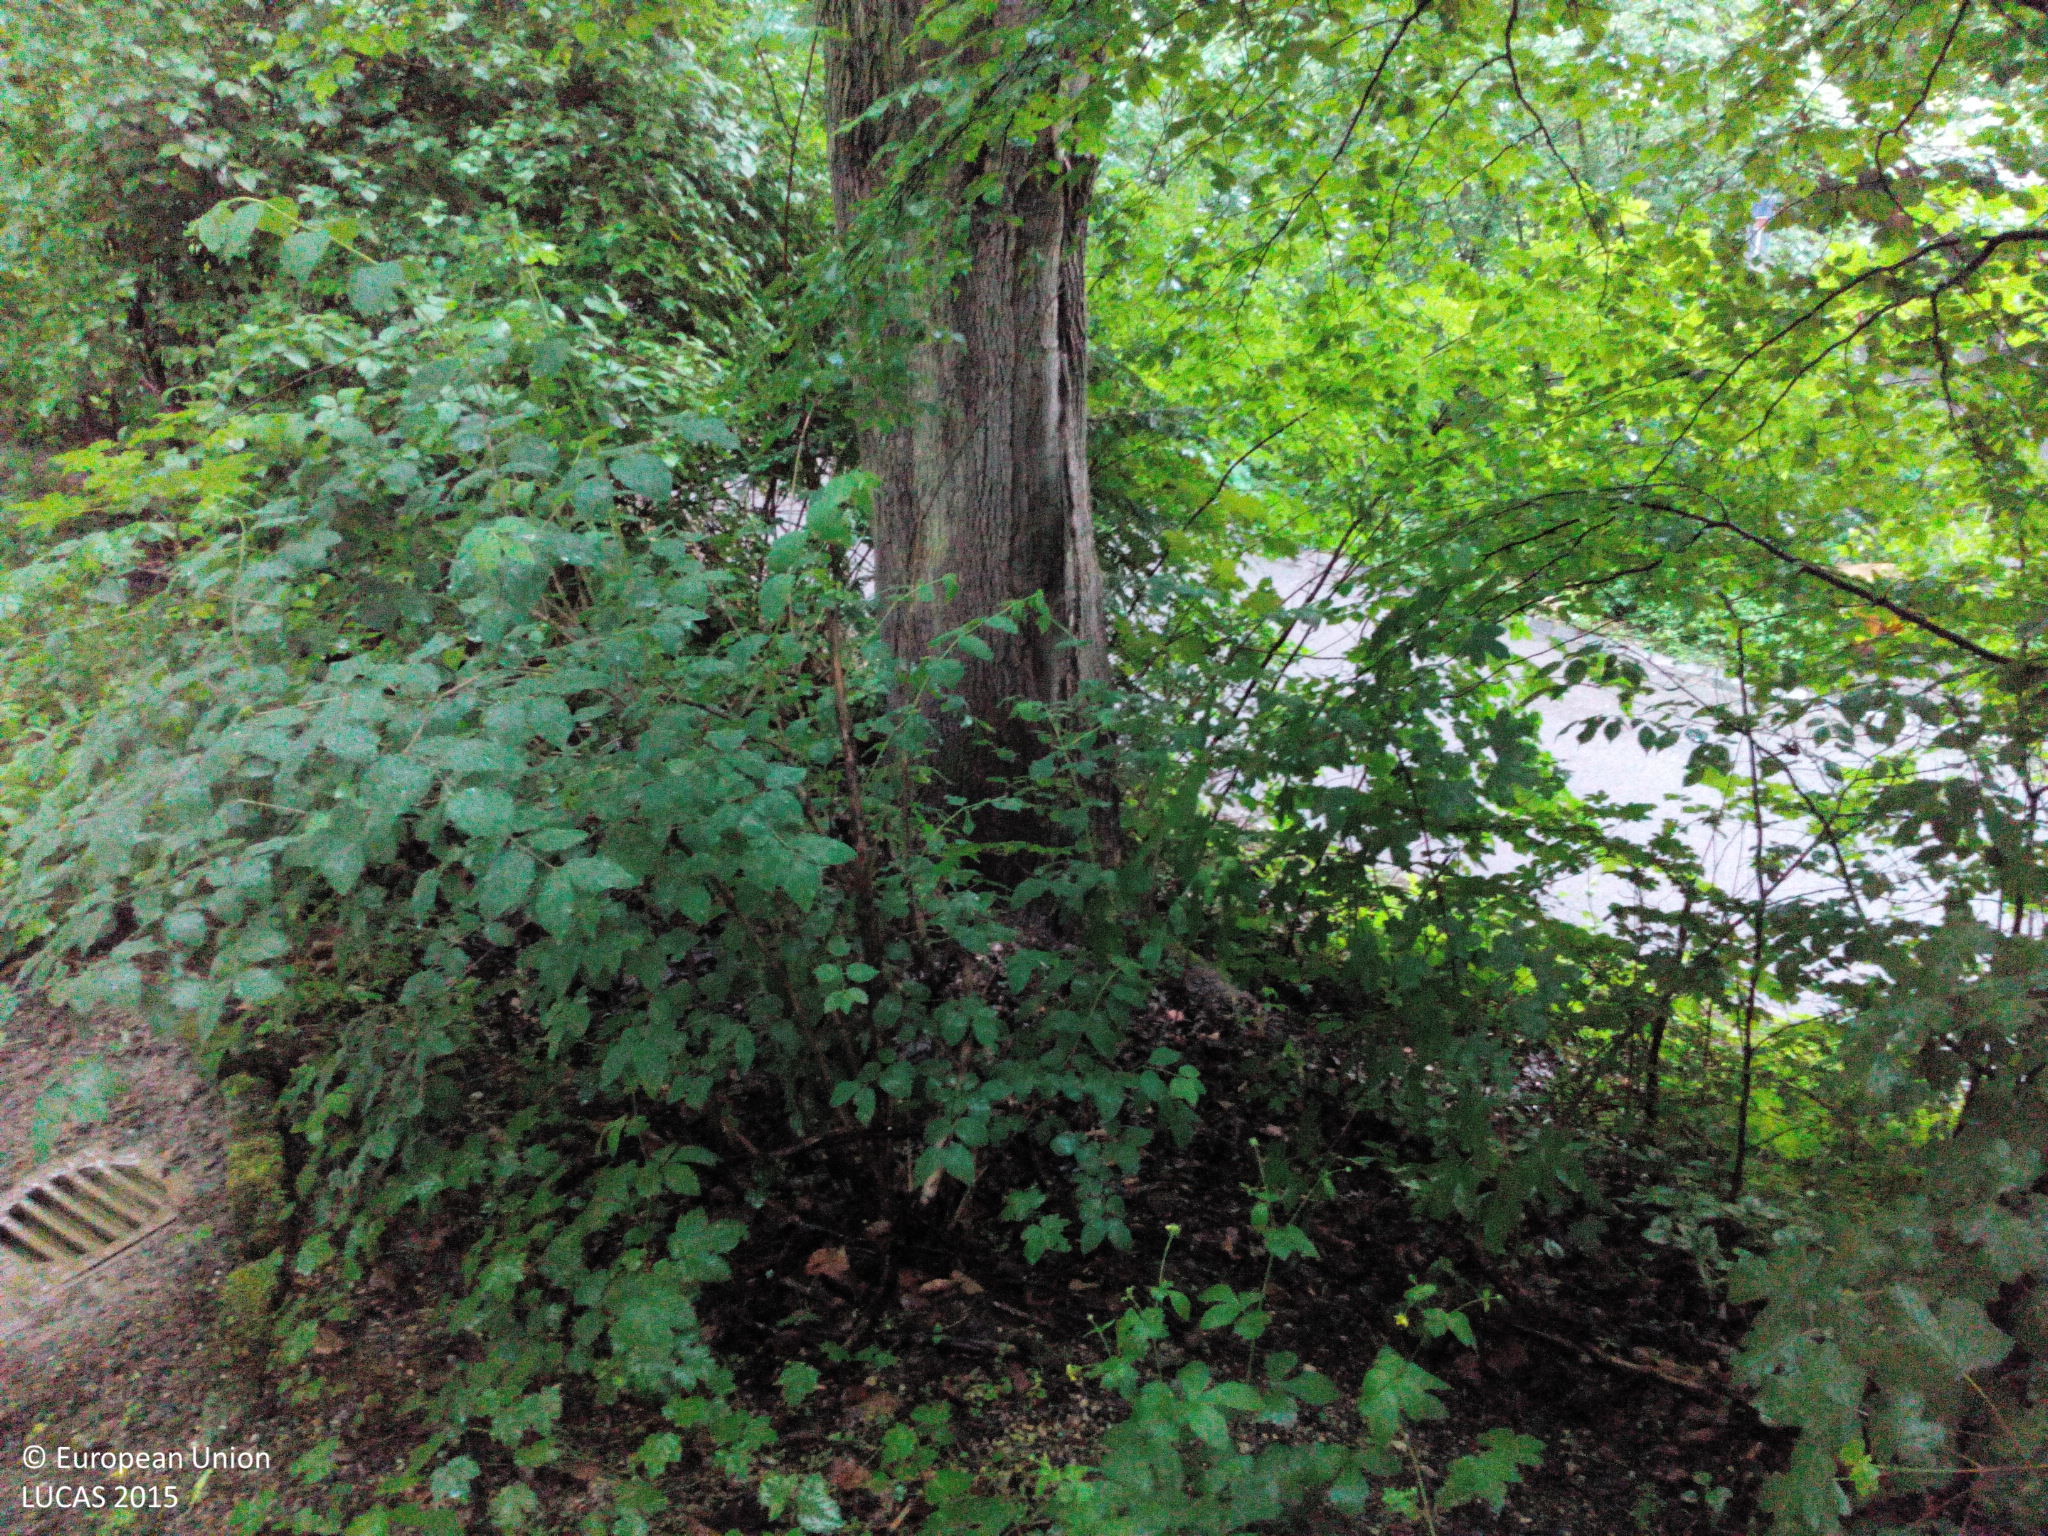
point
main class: Woodland
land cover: Broadleaved woodland
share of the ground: > 75 %
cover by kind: broadleaved forest trees 70 %, shrubs 15 %, unconsolidated bare surface 10 %, coniferous forest trees 5 %
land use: Road transport
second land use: Amenities, museums, leisure
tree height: > 5 m
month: May
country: DE
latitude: 49.0316
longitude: 12.0920
